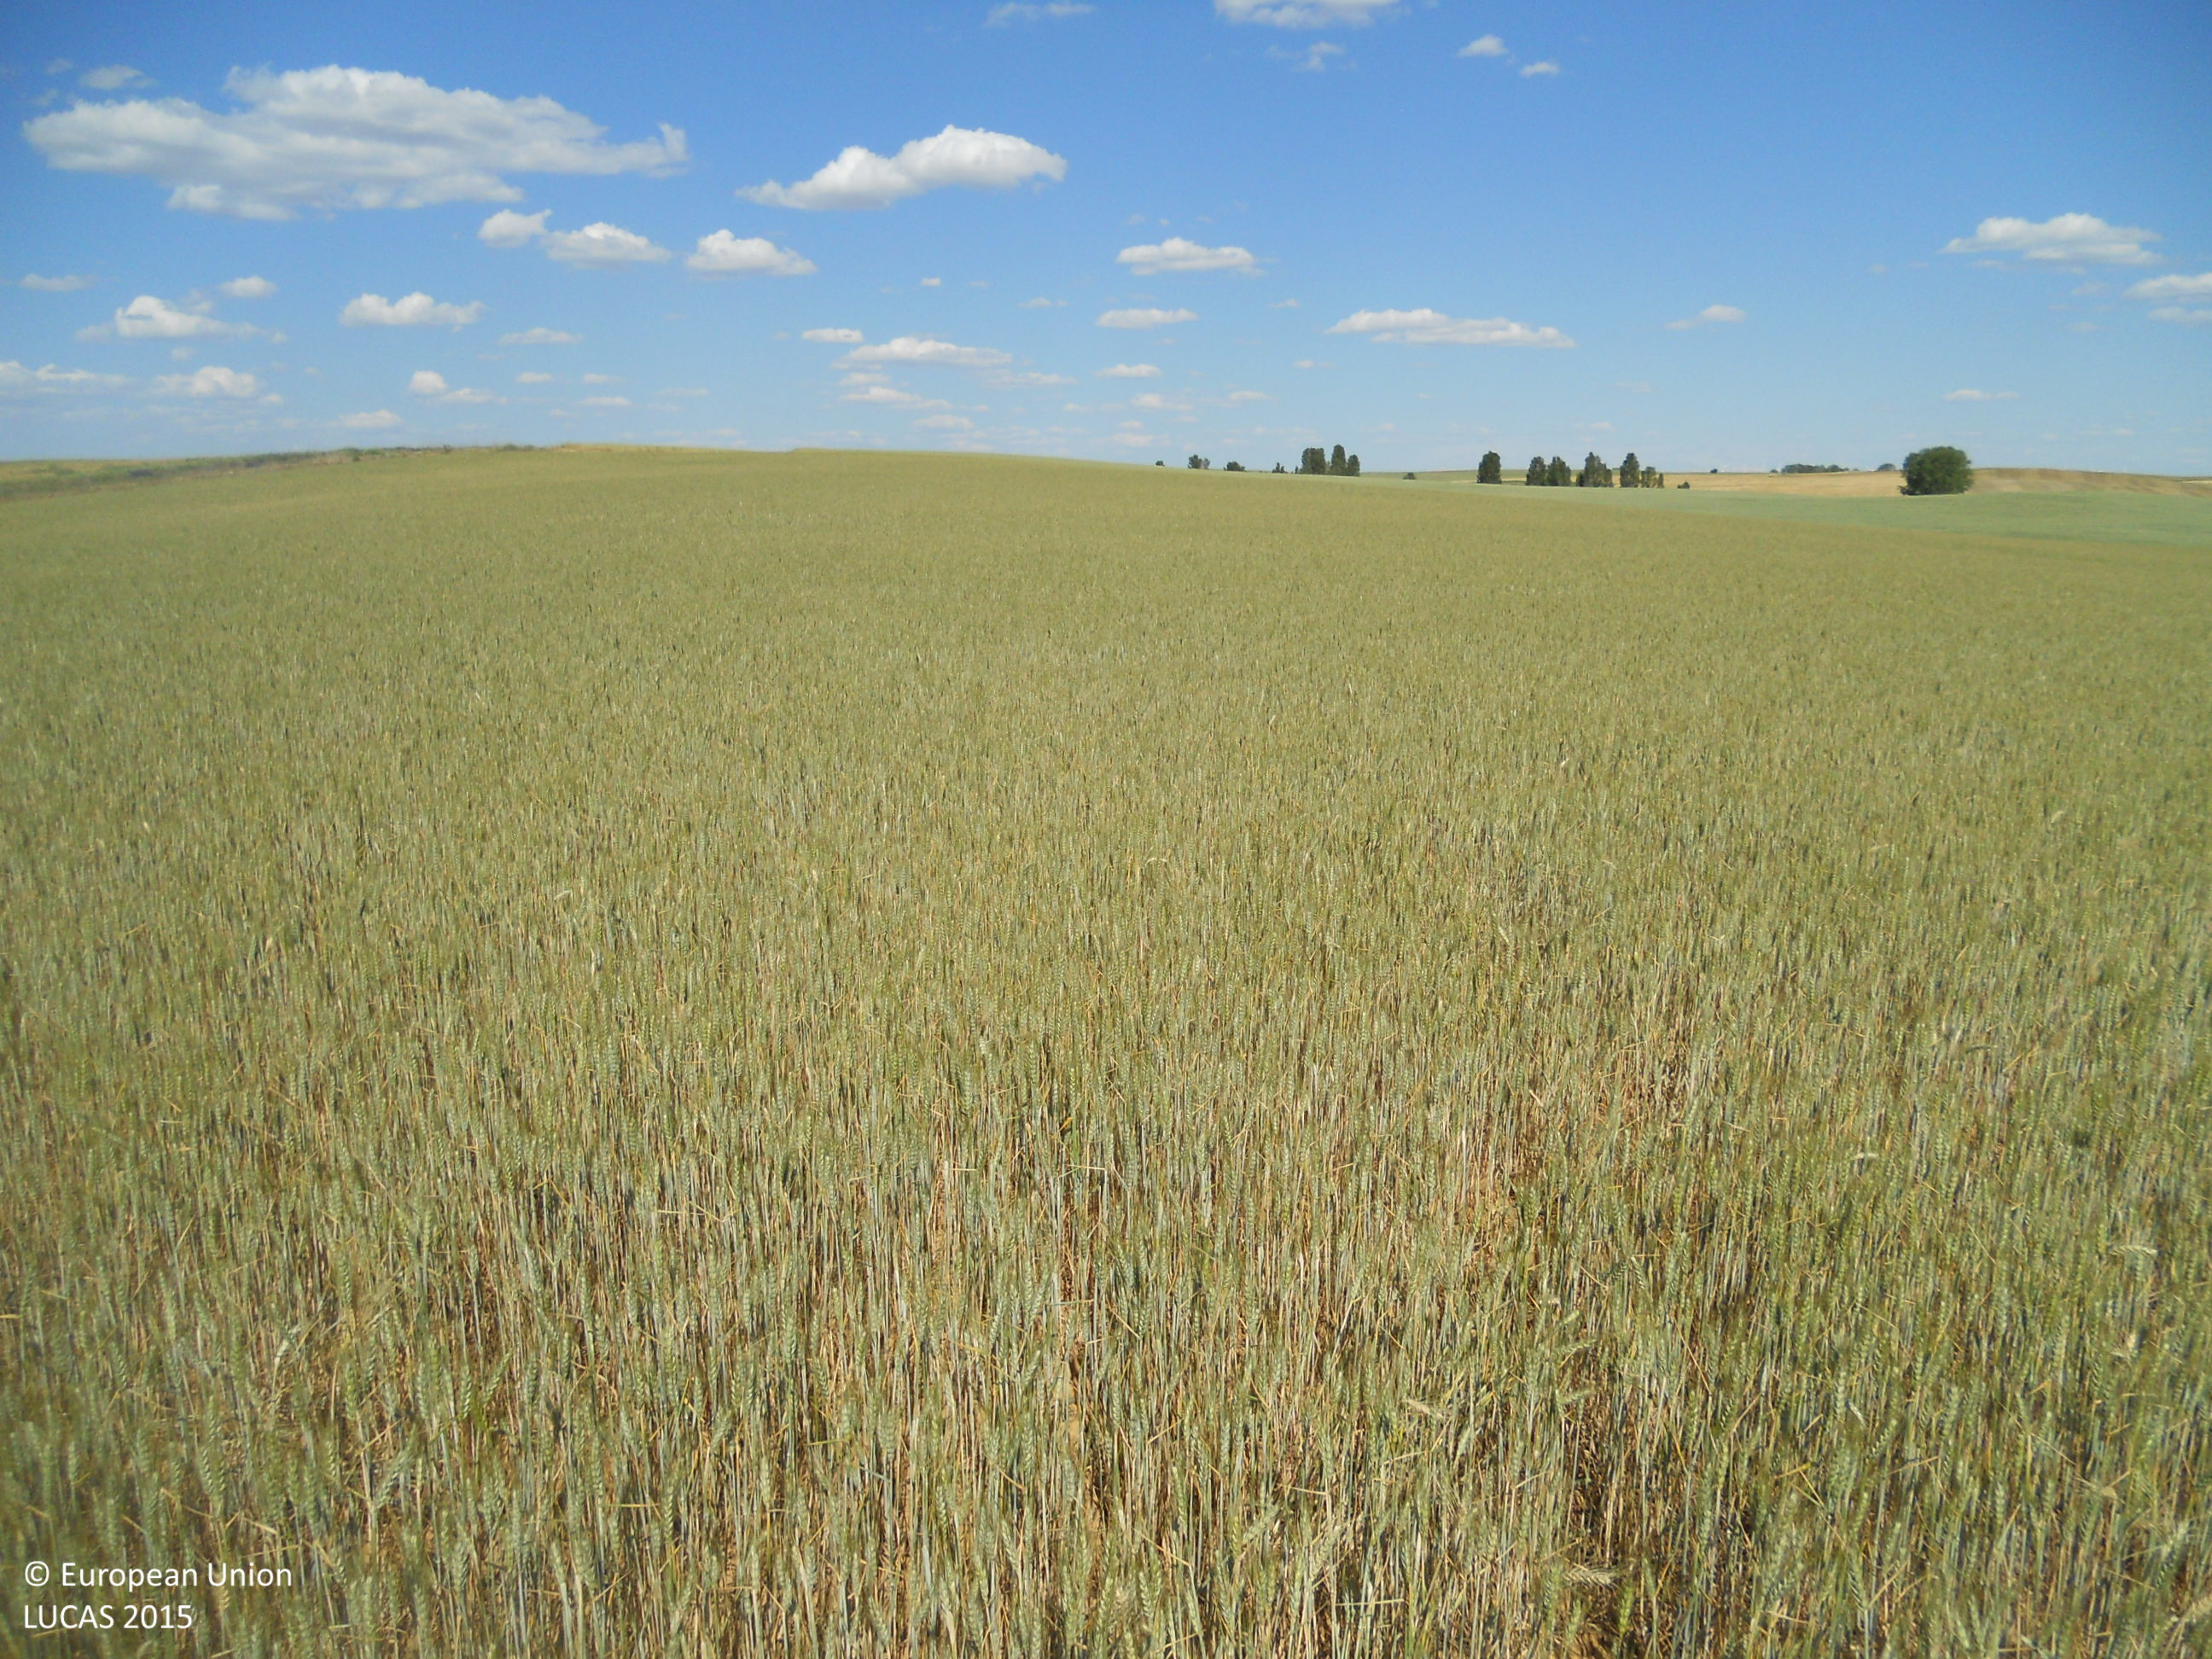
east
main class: Cropland
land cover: Durum wheat
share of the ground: > 75 %
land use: Agriculture (excluding fallow land and kitchen gardens)
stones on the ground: < 10 %
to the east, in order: Durum wheat; Grass margins; Temporary grasslands; Grass margins; Common wheat
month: May
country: ES
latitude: 42.2874
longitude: -4.8382
